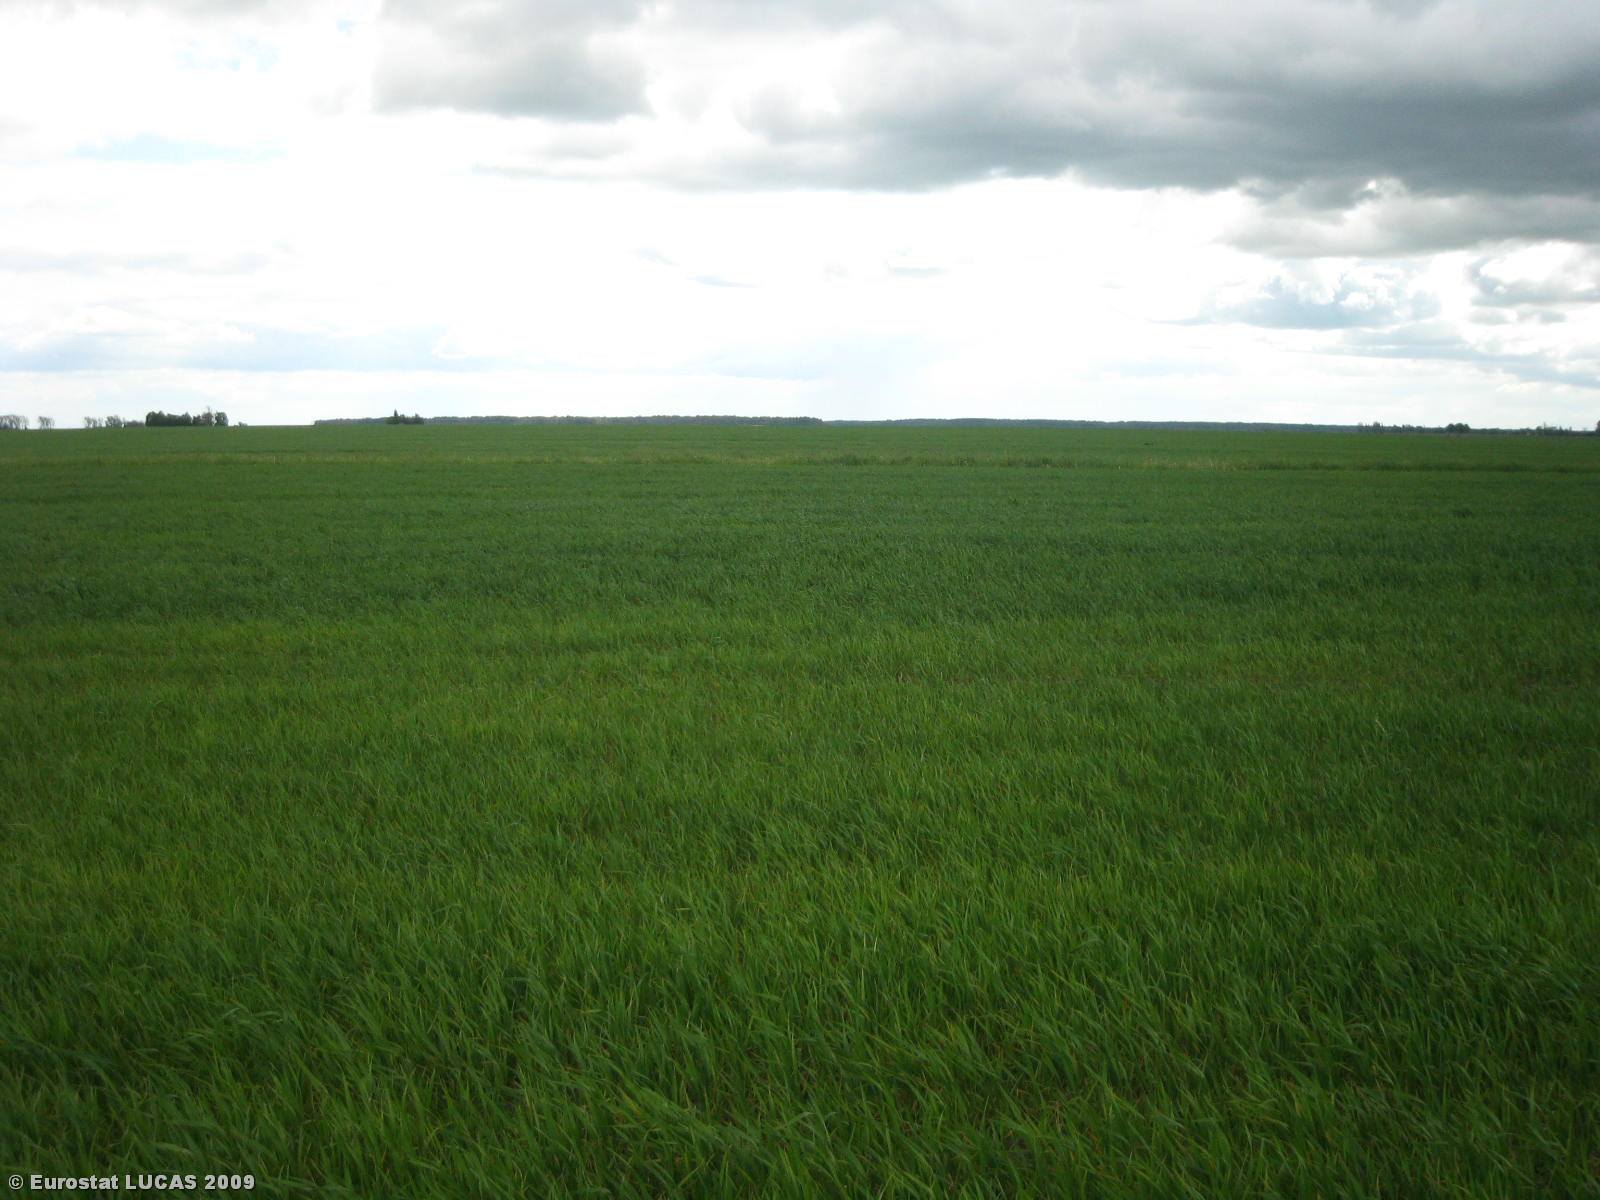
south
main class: Cropland
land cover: Common wheat
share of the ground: > 75 %
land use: Agriculture (excluding fallow land and kitchen gardens)
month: May
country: LT
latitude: 56.0117
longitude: 24.0590
